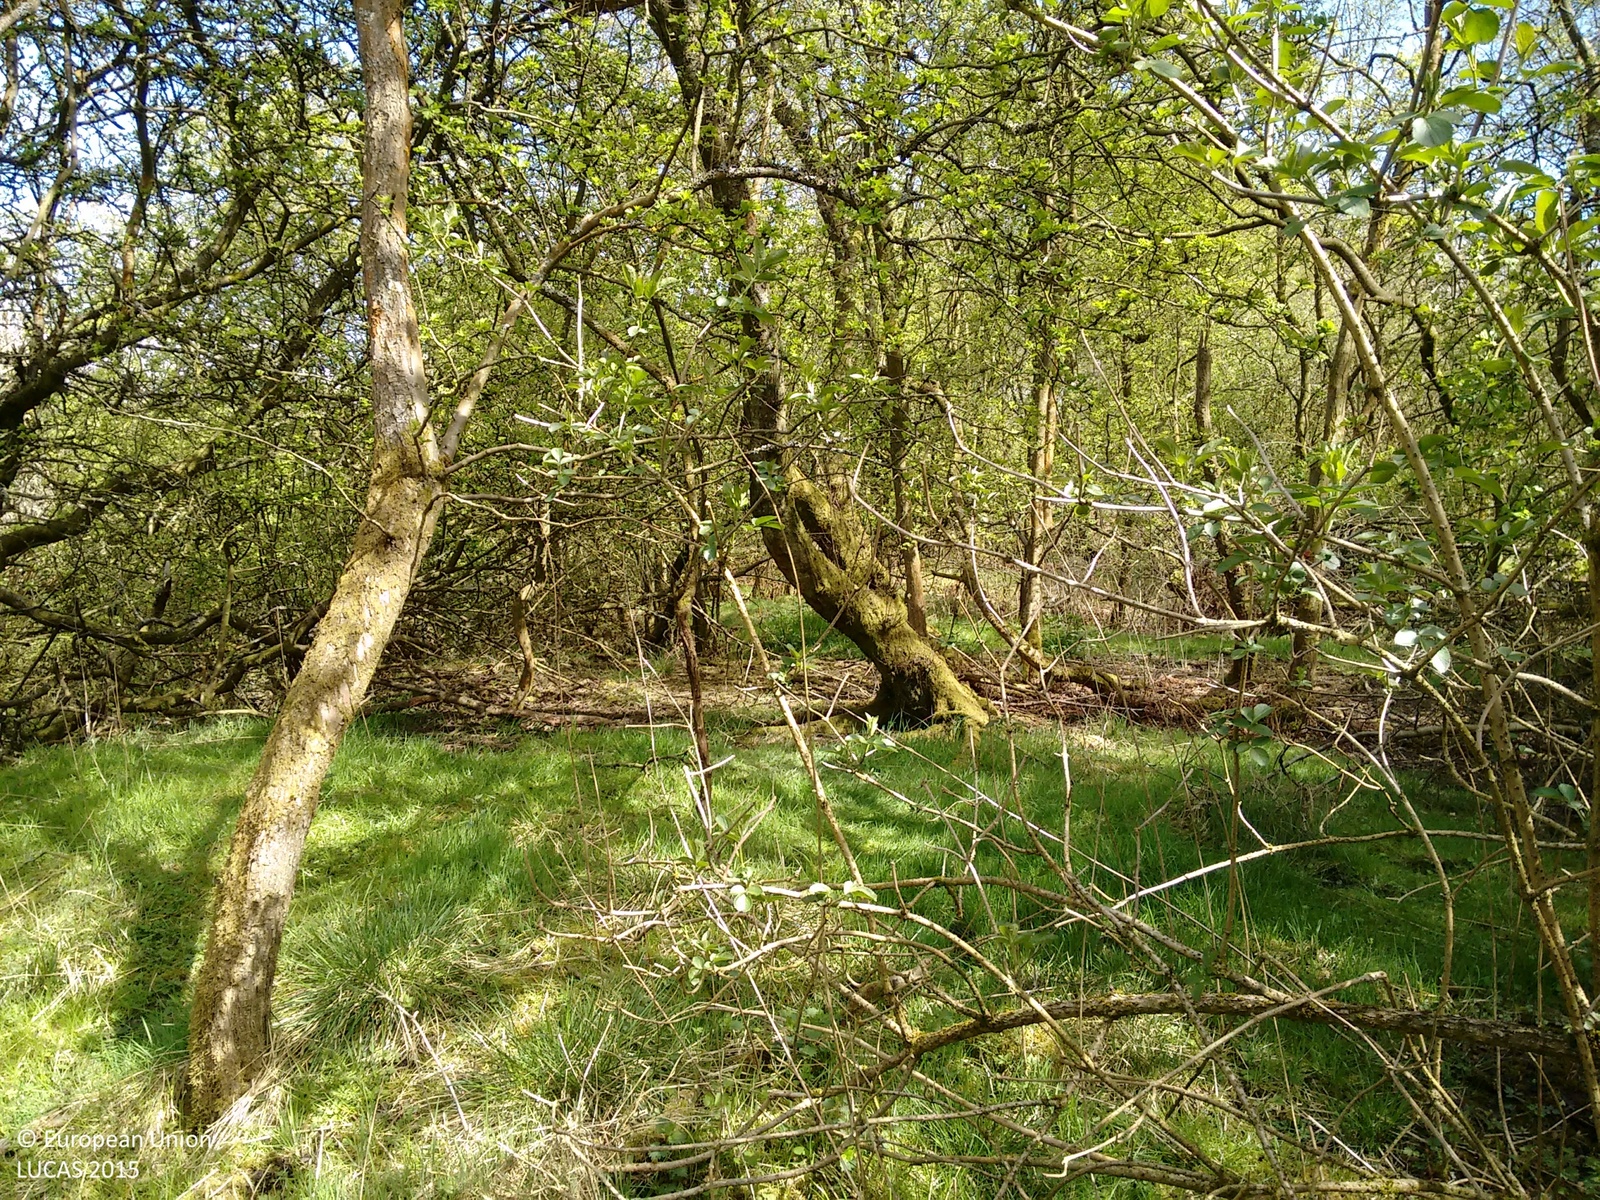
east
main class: Woodland
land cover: Broadleaved woodland
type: exotic forest
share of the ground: > 75 %
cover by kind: broadleaved forest trees 90 %, herbaceous plants 10 %
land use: Semi-natural and natural areas not in use
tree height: > 5 m
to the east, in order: Broadleaved woodland; Fences; Grass margins; Tracks; Grass margins; Fences; Grassland without tree/shrub cover; Single bushes/trees; Fences; Other mixed woodland
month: May
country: GB
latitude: 55.8922
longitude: -3.9828
